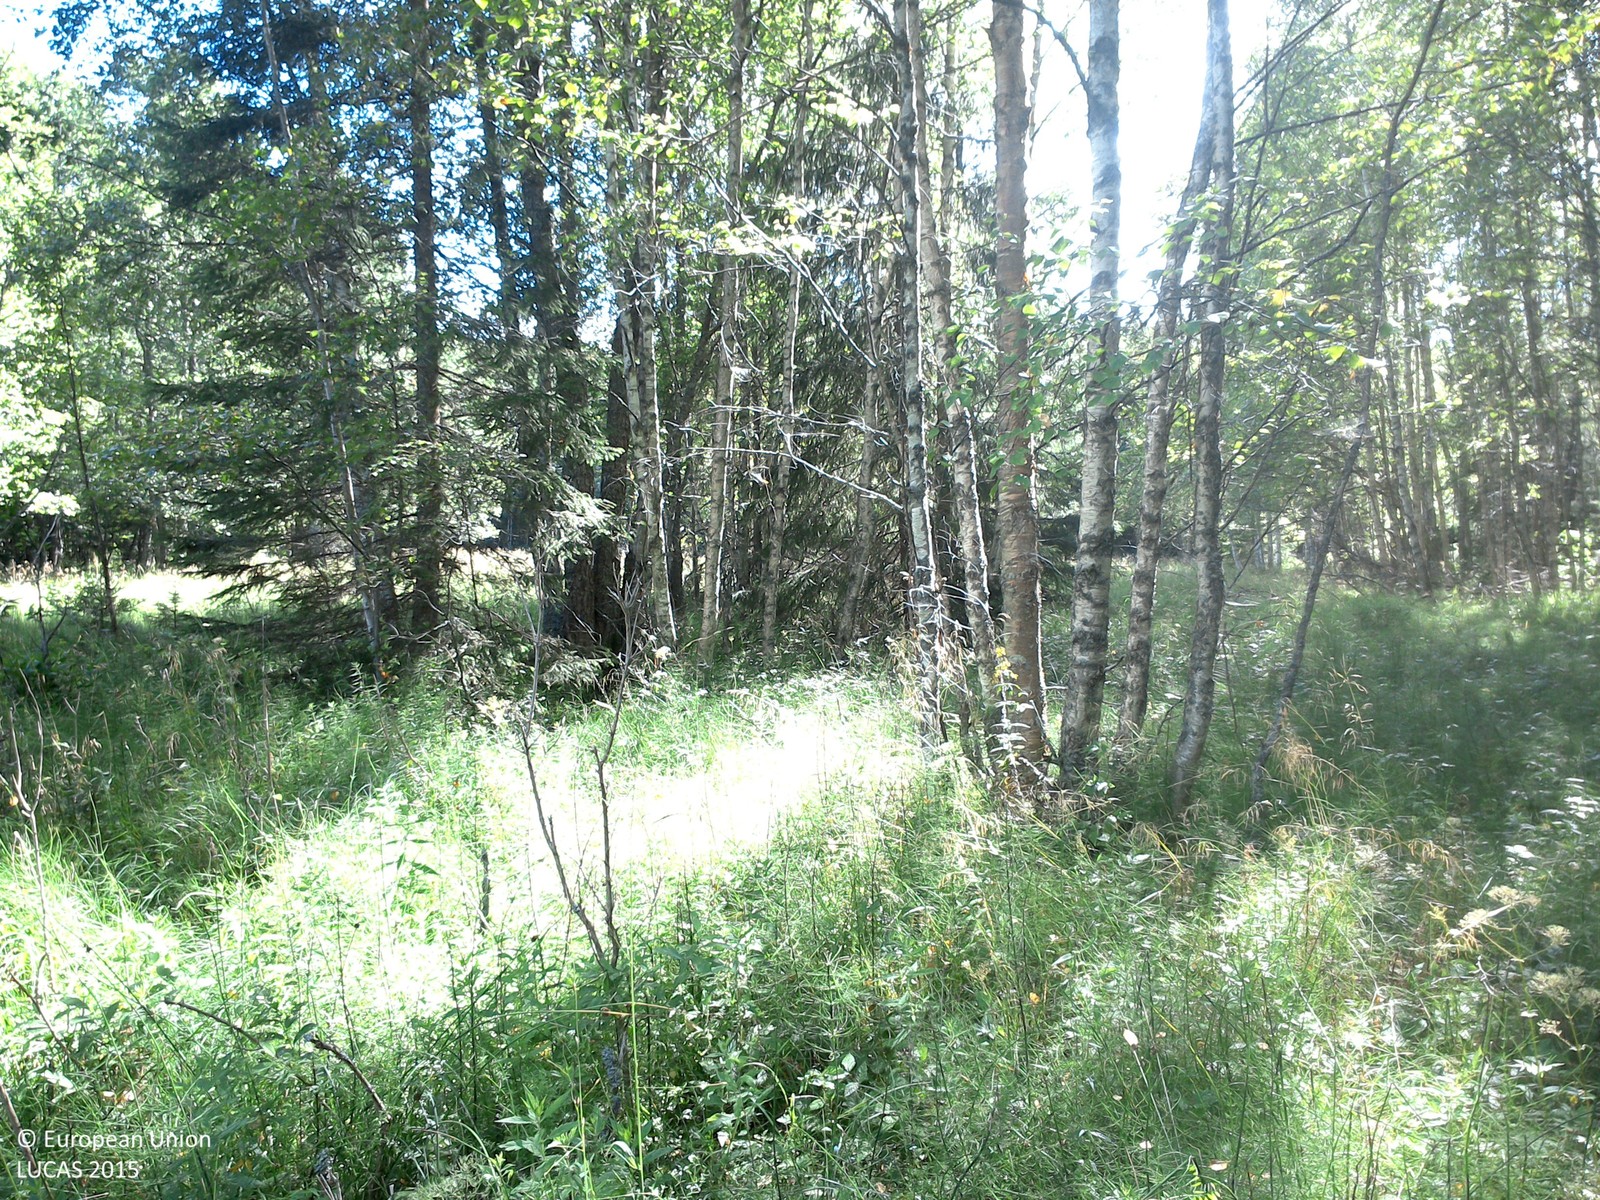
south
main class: Woodland
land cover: Broadleaved woodland
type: mire and swamp forests
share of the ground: 25 - 50 %
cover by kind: herbaceous plants 70 %, broadleaved forest trees 30 %
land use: Forestry
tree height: > 5 m
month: August
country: SE
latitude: 57.9108
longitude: 15.4471
